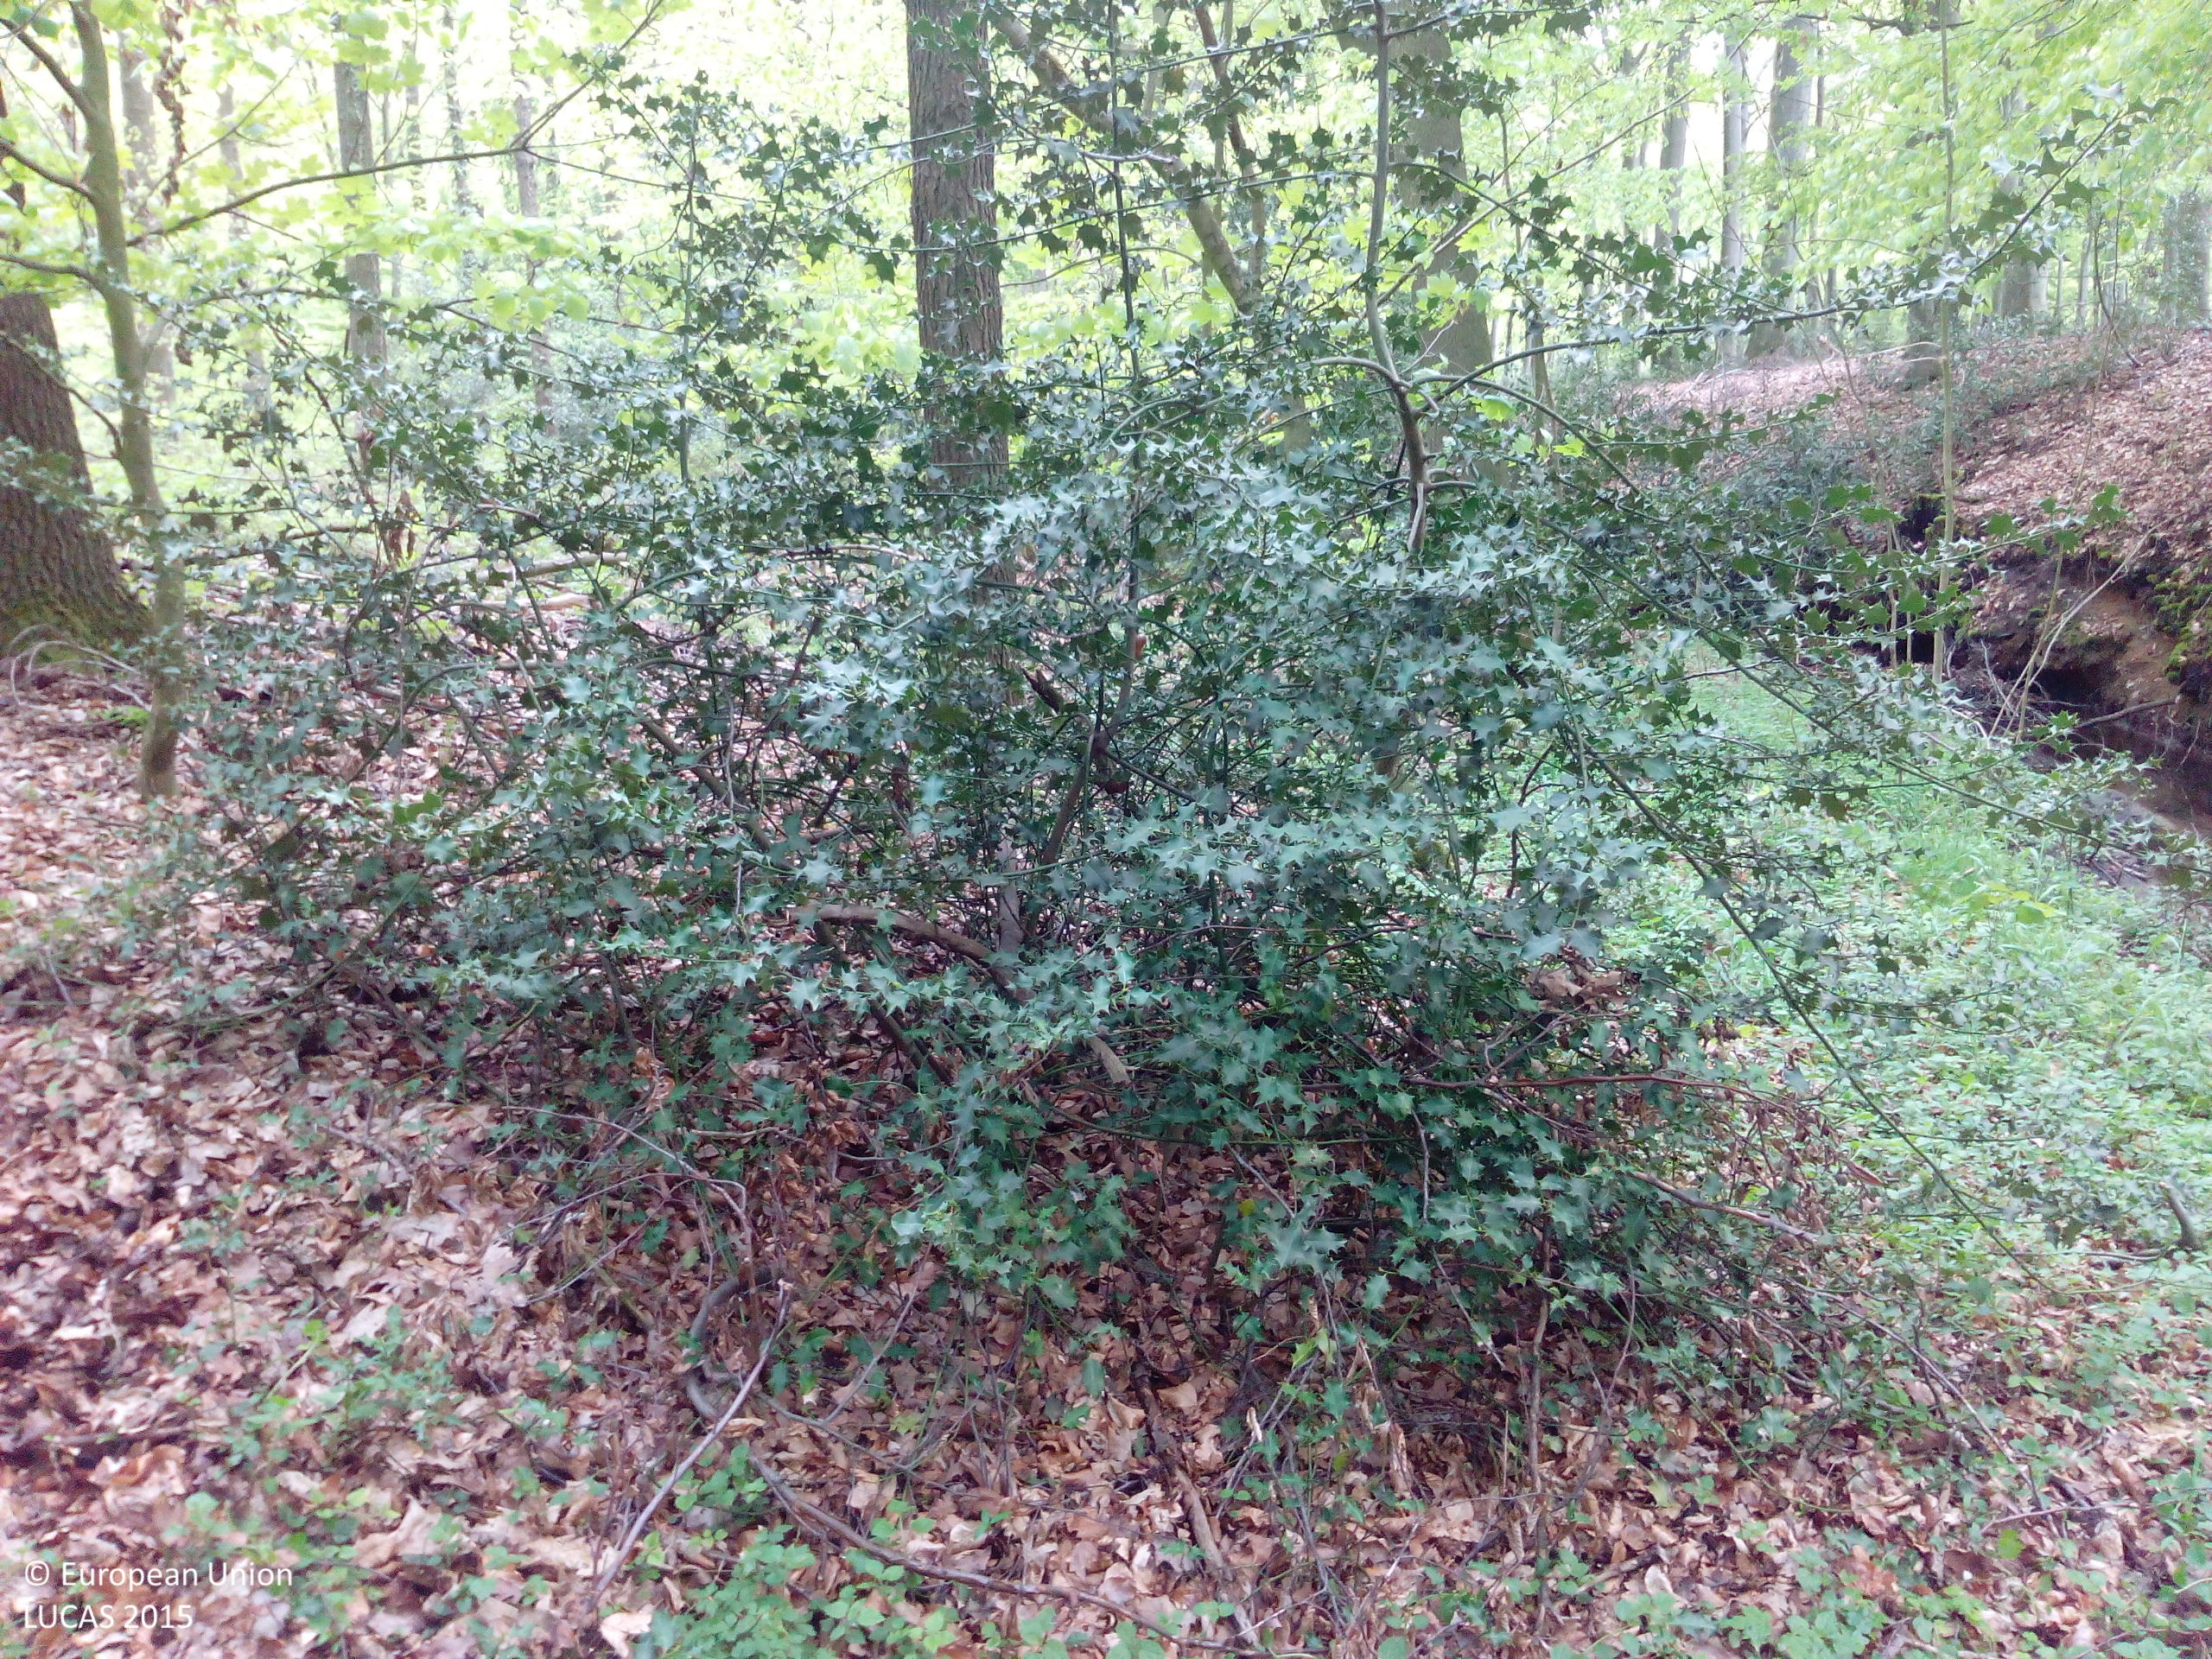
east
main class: Woodland
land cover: Broadleaved woodland
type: mesophytic deciduous forest
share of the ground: > 75 %
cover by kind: broadleaved forest trees 90 %, shrubs 5 %, unconsolidated bare surface 5 %
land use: Forestry
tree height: > 5 m
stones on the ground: < 10 %
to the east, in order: Broadleaved woodland; Rivers and streams; Broadleaved woodland; Rivers and streams; Broadleaved woodland; Rivers and streams; Broadleaved woodland
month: May
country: DE
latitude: 51.6659
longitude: 7.4122
